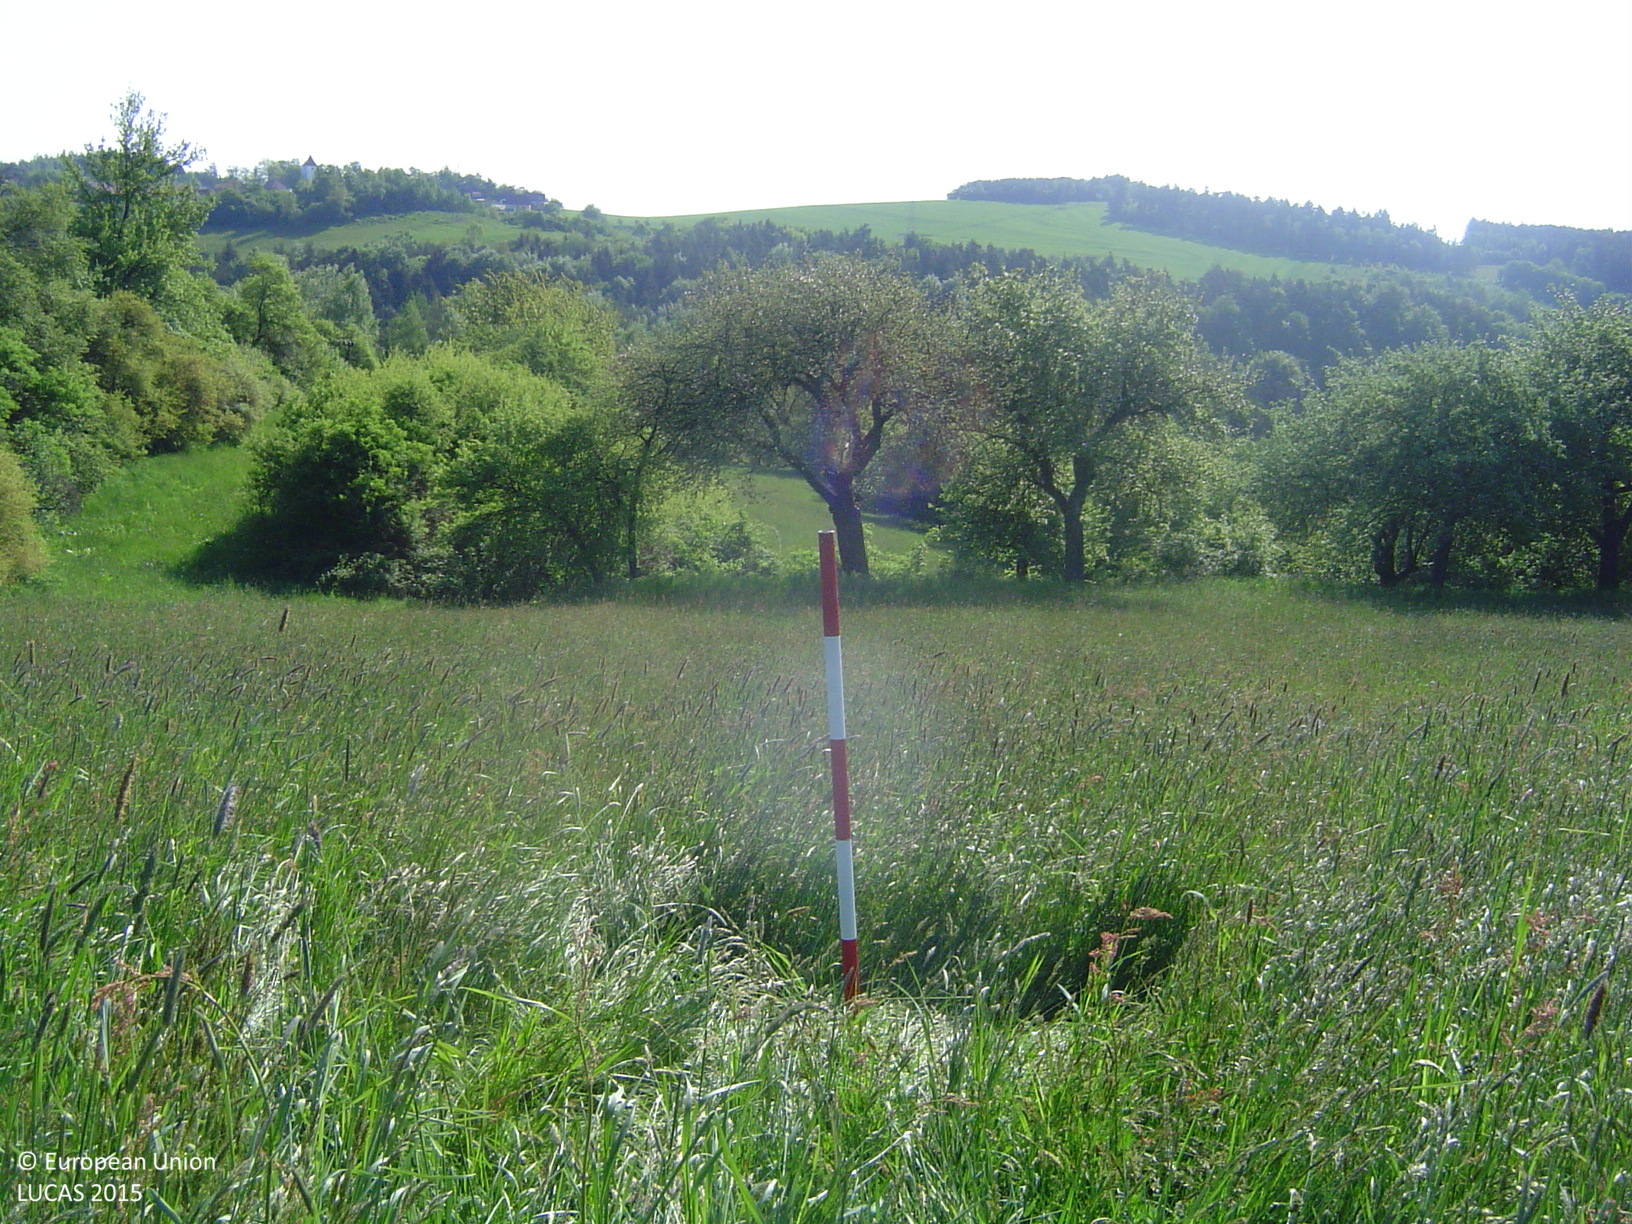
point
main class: Grassland
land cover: Grassland without tree/shrub cover
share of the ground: > 75 %
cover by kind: herbaceous plants 95 %, shrubs 5 %
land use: Agriculture (excluding fallow land and kitchen gardens)
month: May
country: CZ
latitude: 49.4160
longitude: 16.2781
